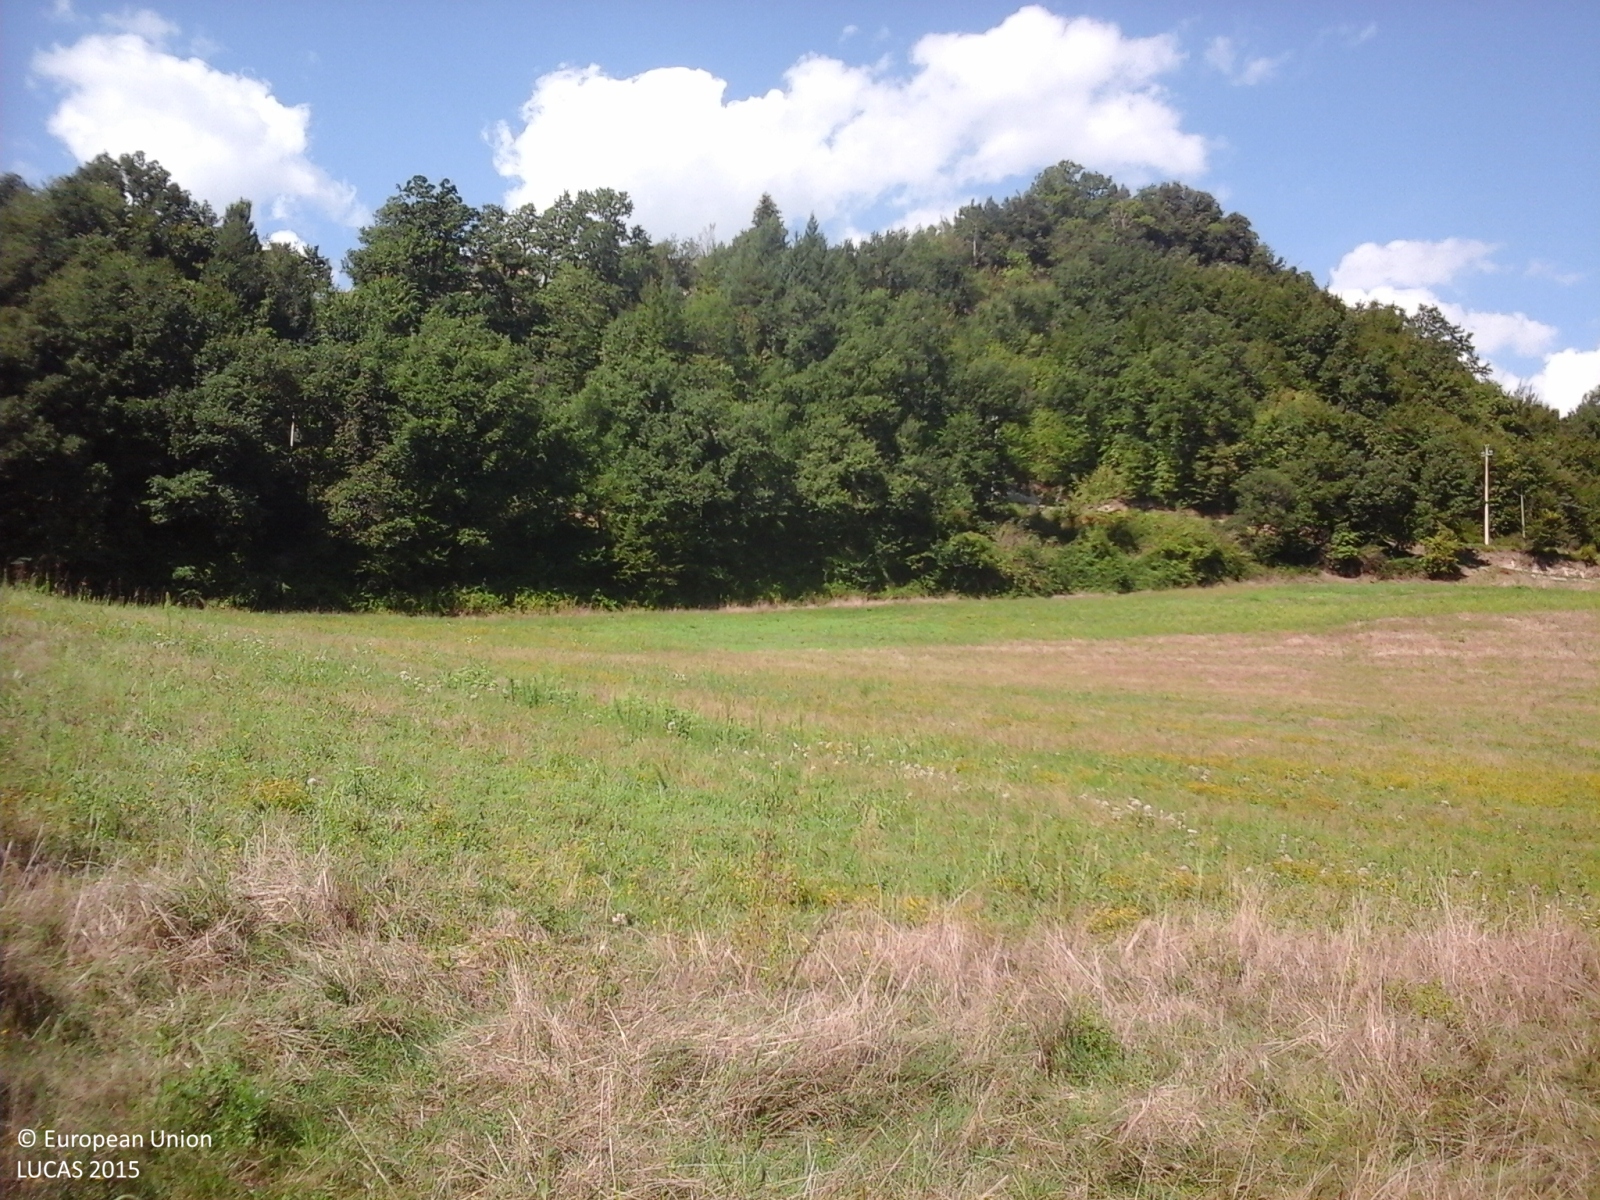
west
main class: Grassland
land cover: Grassland without tree/shrub cover
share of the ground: > 75 %
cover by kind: herbaceous plants 100 %
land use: Agriculture (excluding fallow land and kitchen gardens)
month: August
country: IT
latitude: 42.9597
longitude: 13.3617
